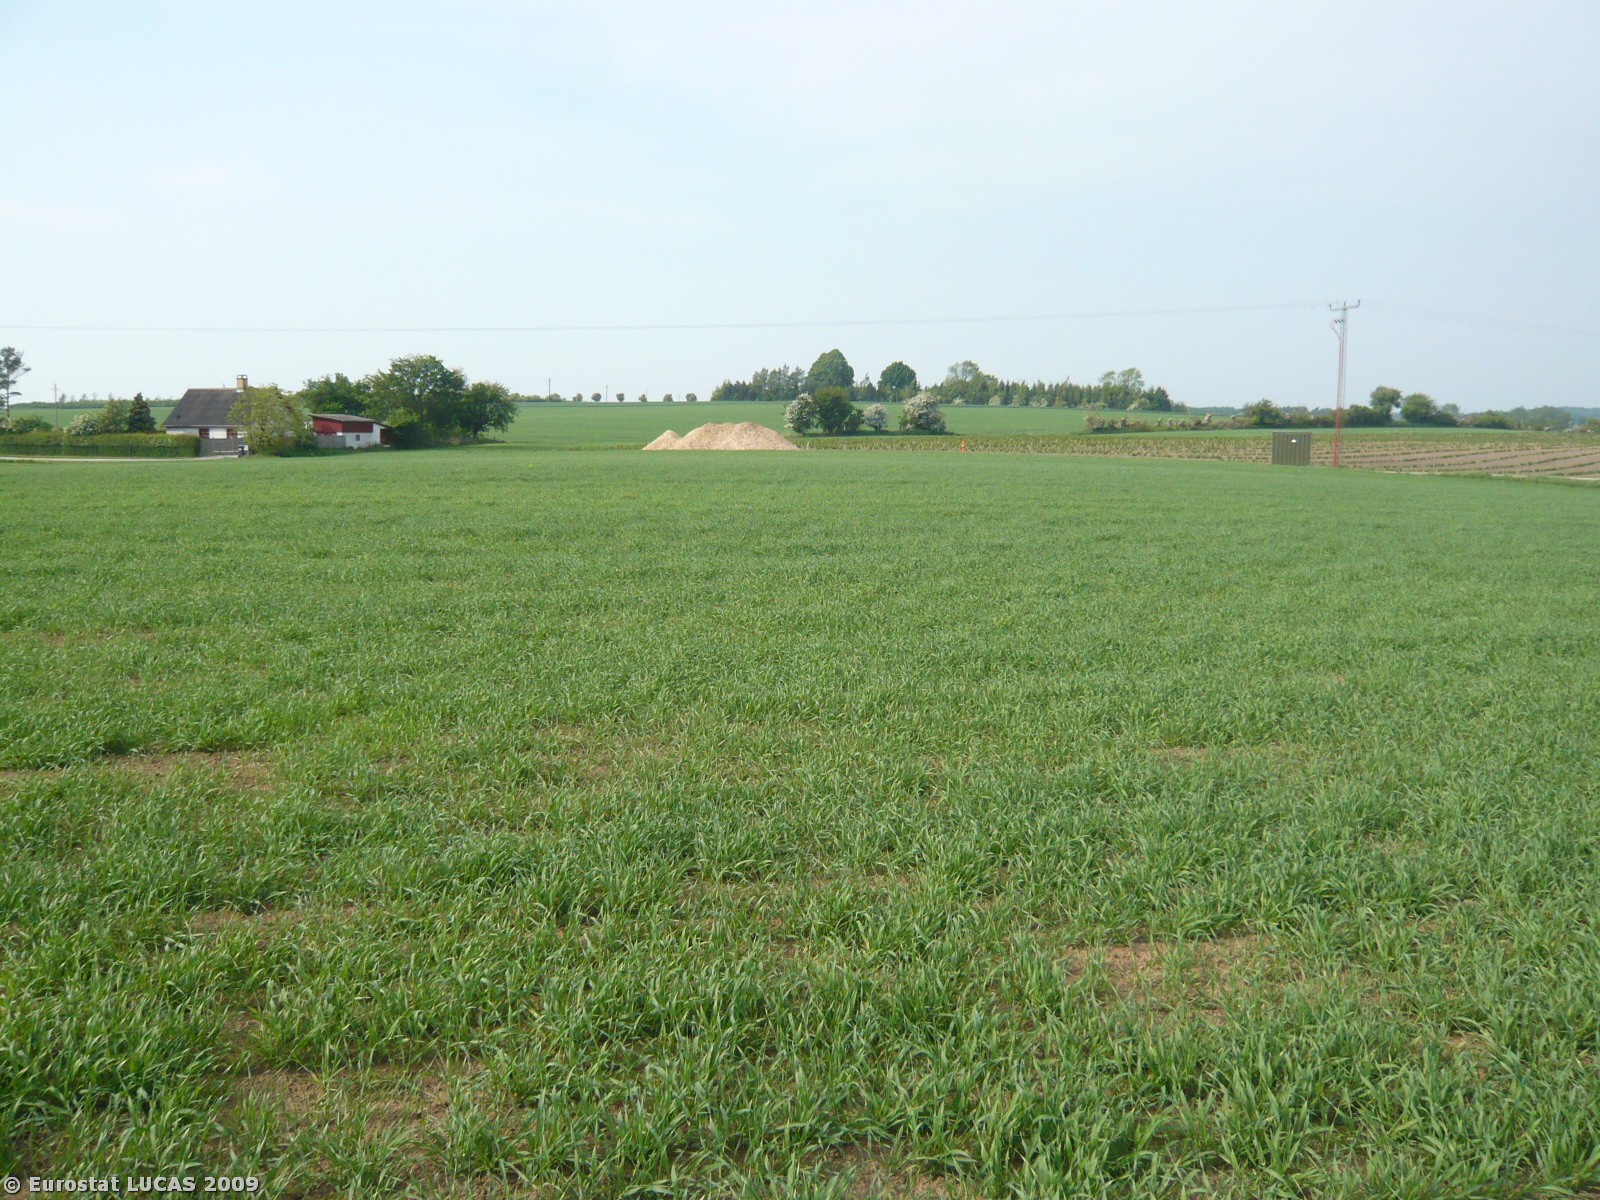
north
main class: Cropland
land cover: Barley
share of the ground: 50 - 75 %
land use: Agriculture (excluding fallow land and kitchen gardens)
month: May
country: DK
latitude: 55.2423
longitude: 11.6501
